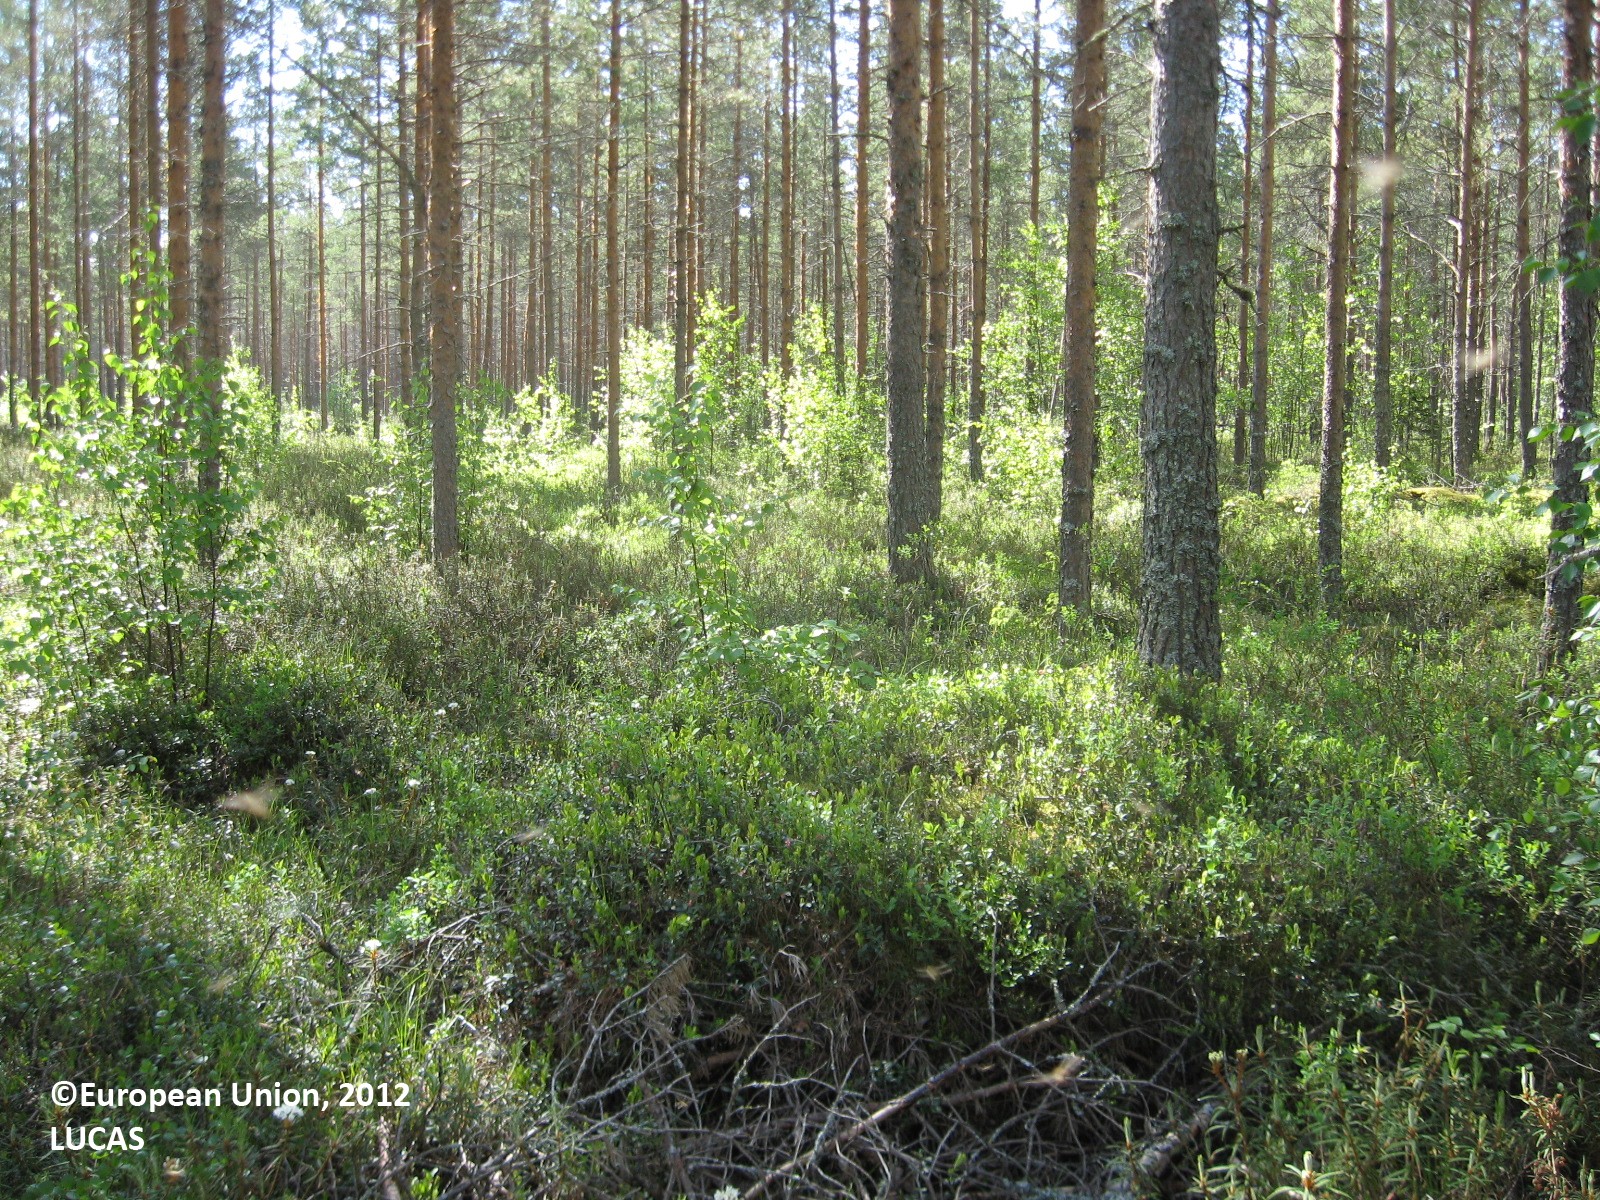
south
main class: Woodland
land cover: Pine dominated coniferous woodland
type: boreal forest
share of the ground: 50 - 75 %
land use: Forestry
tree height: > 5 m
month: June
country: FI
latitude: 63.2058
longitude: 22.7187
